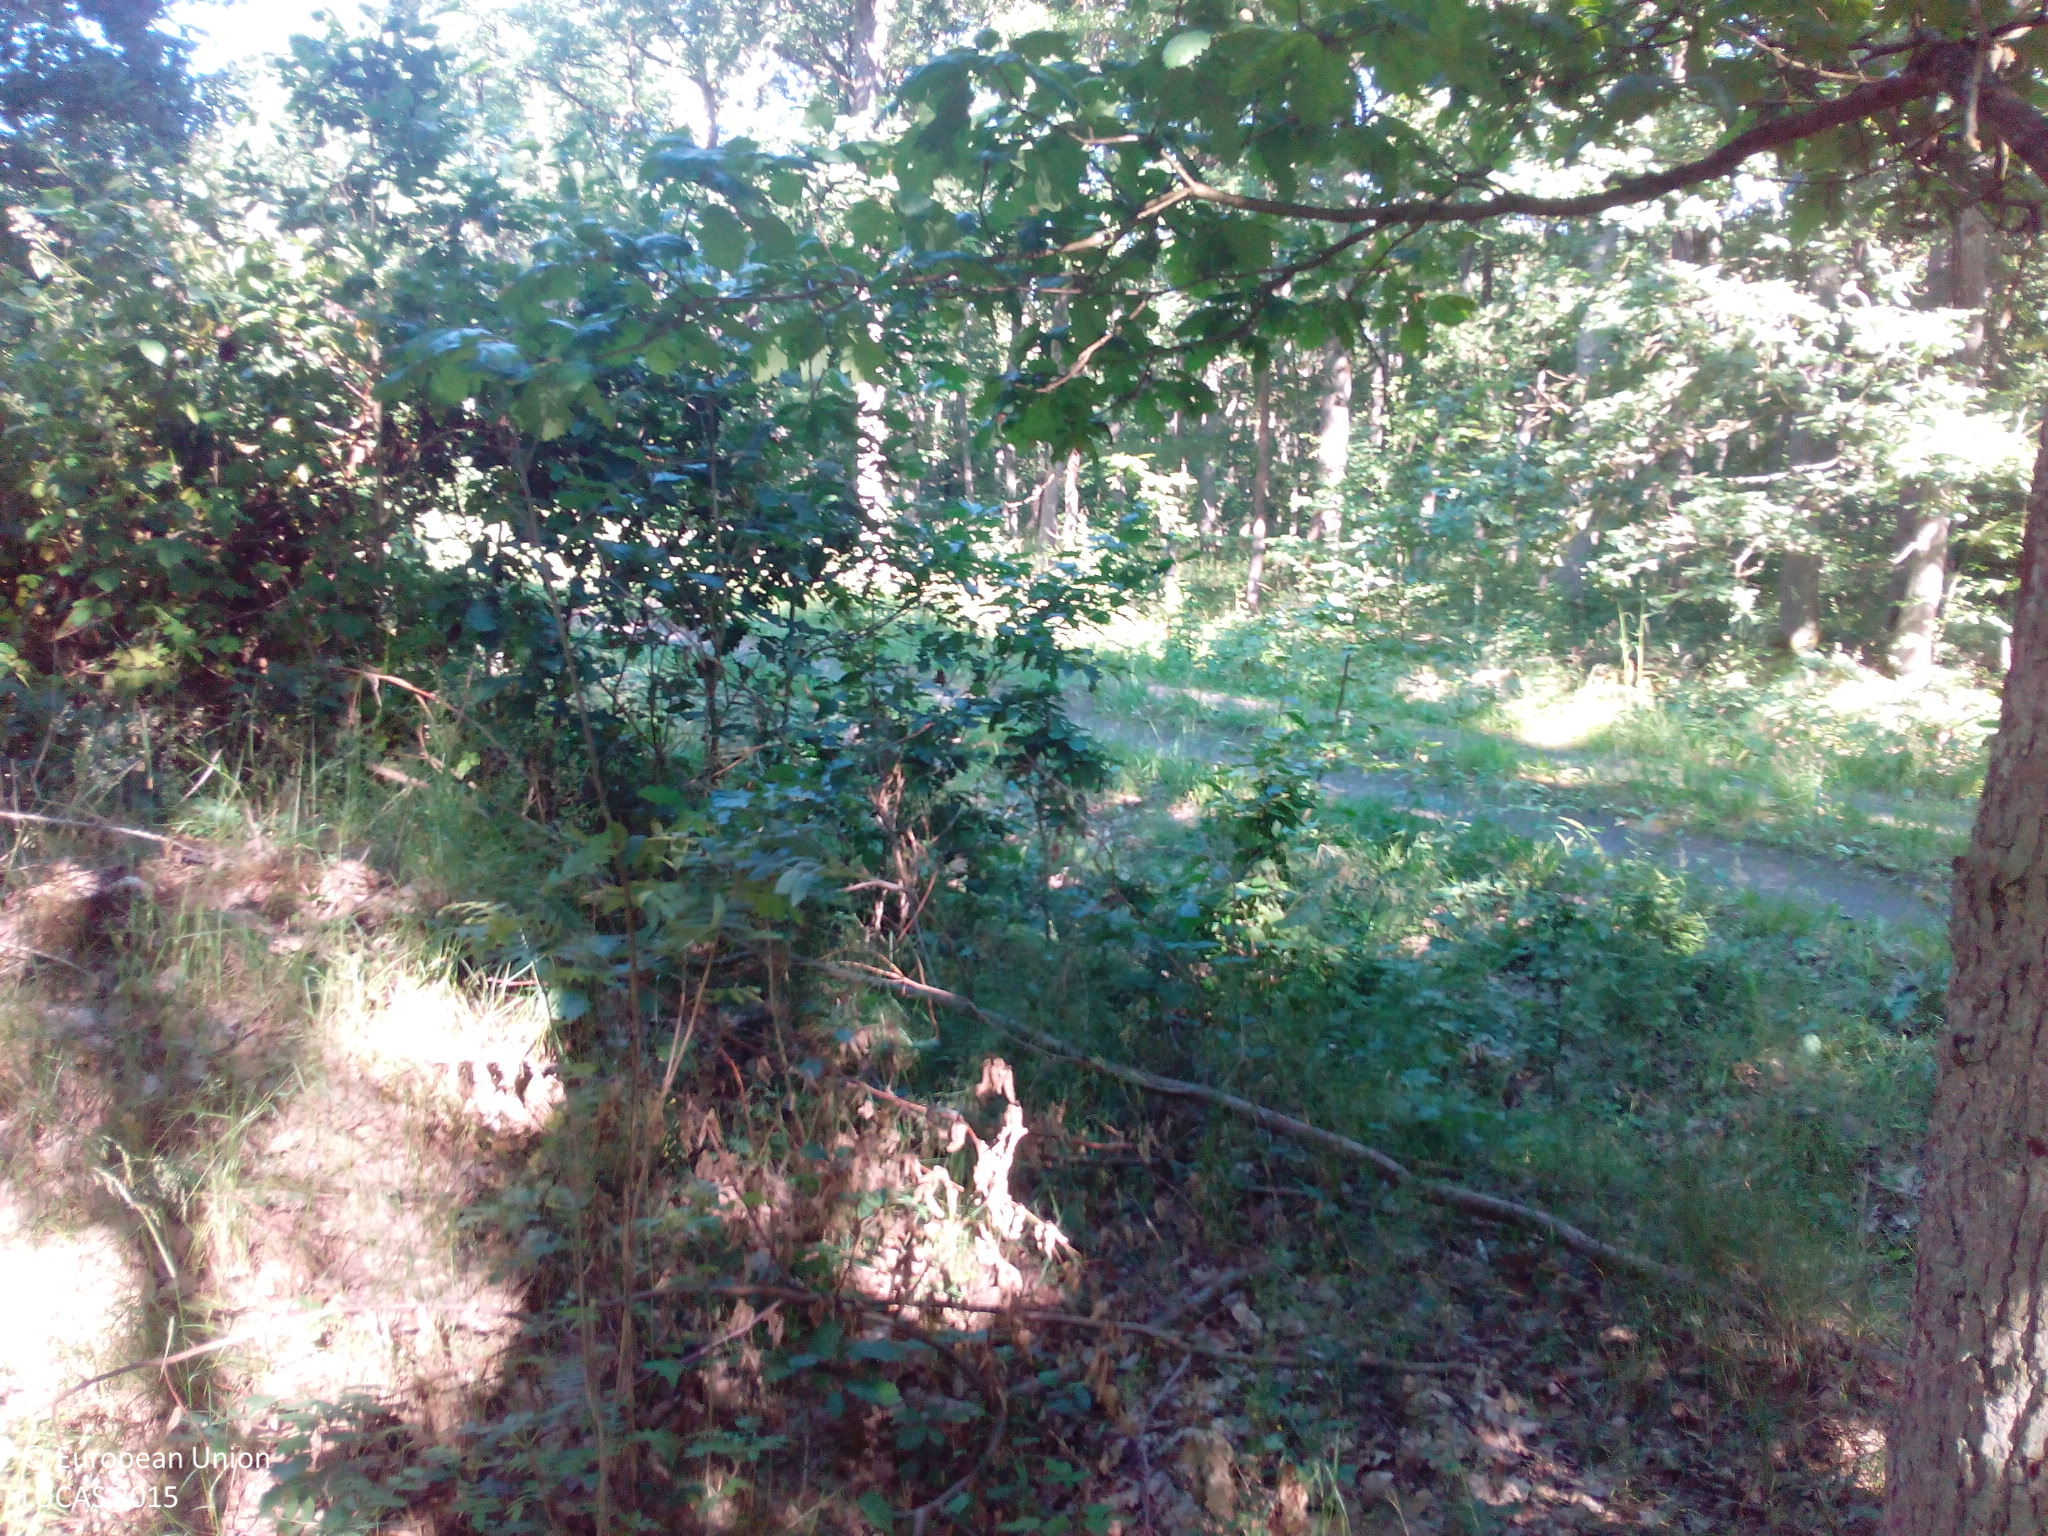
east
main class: Woodland
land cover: Broadleaved woodland
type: mesophytic deciduous forest
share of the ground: > 75 %
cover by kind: broadleaved forest trees 85 %, herbaceous plants 15 %
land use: Forestry
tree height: > 5 m
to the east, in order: Broadleaved woodland; Ditches and canals; Grass margins; Tracks; Grass margins; Broadleaved woodland; Tracks; Broadleaved woodland
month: July
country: DE
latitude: 50.3443
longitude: 10.6321
